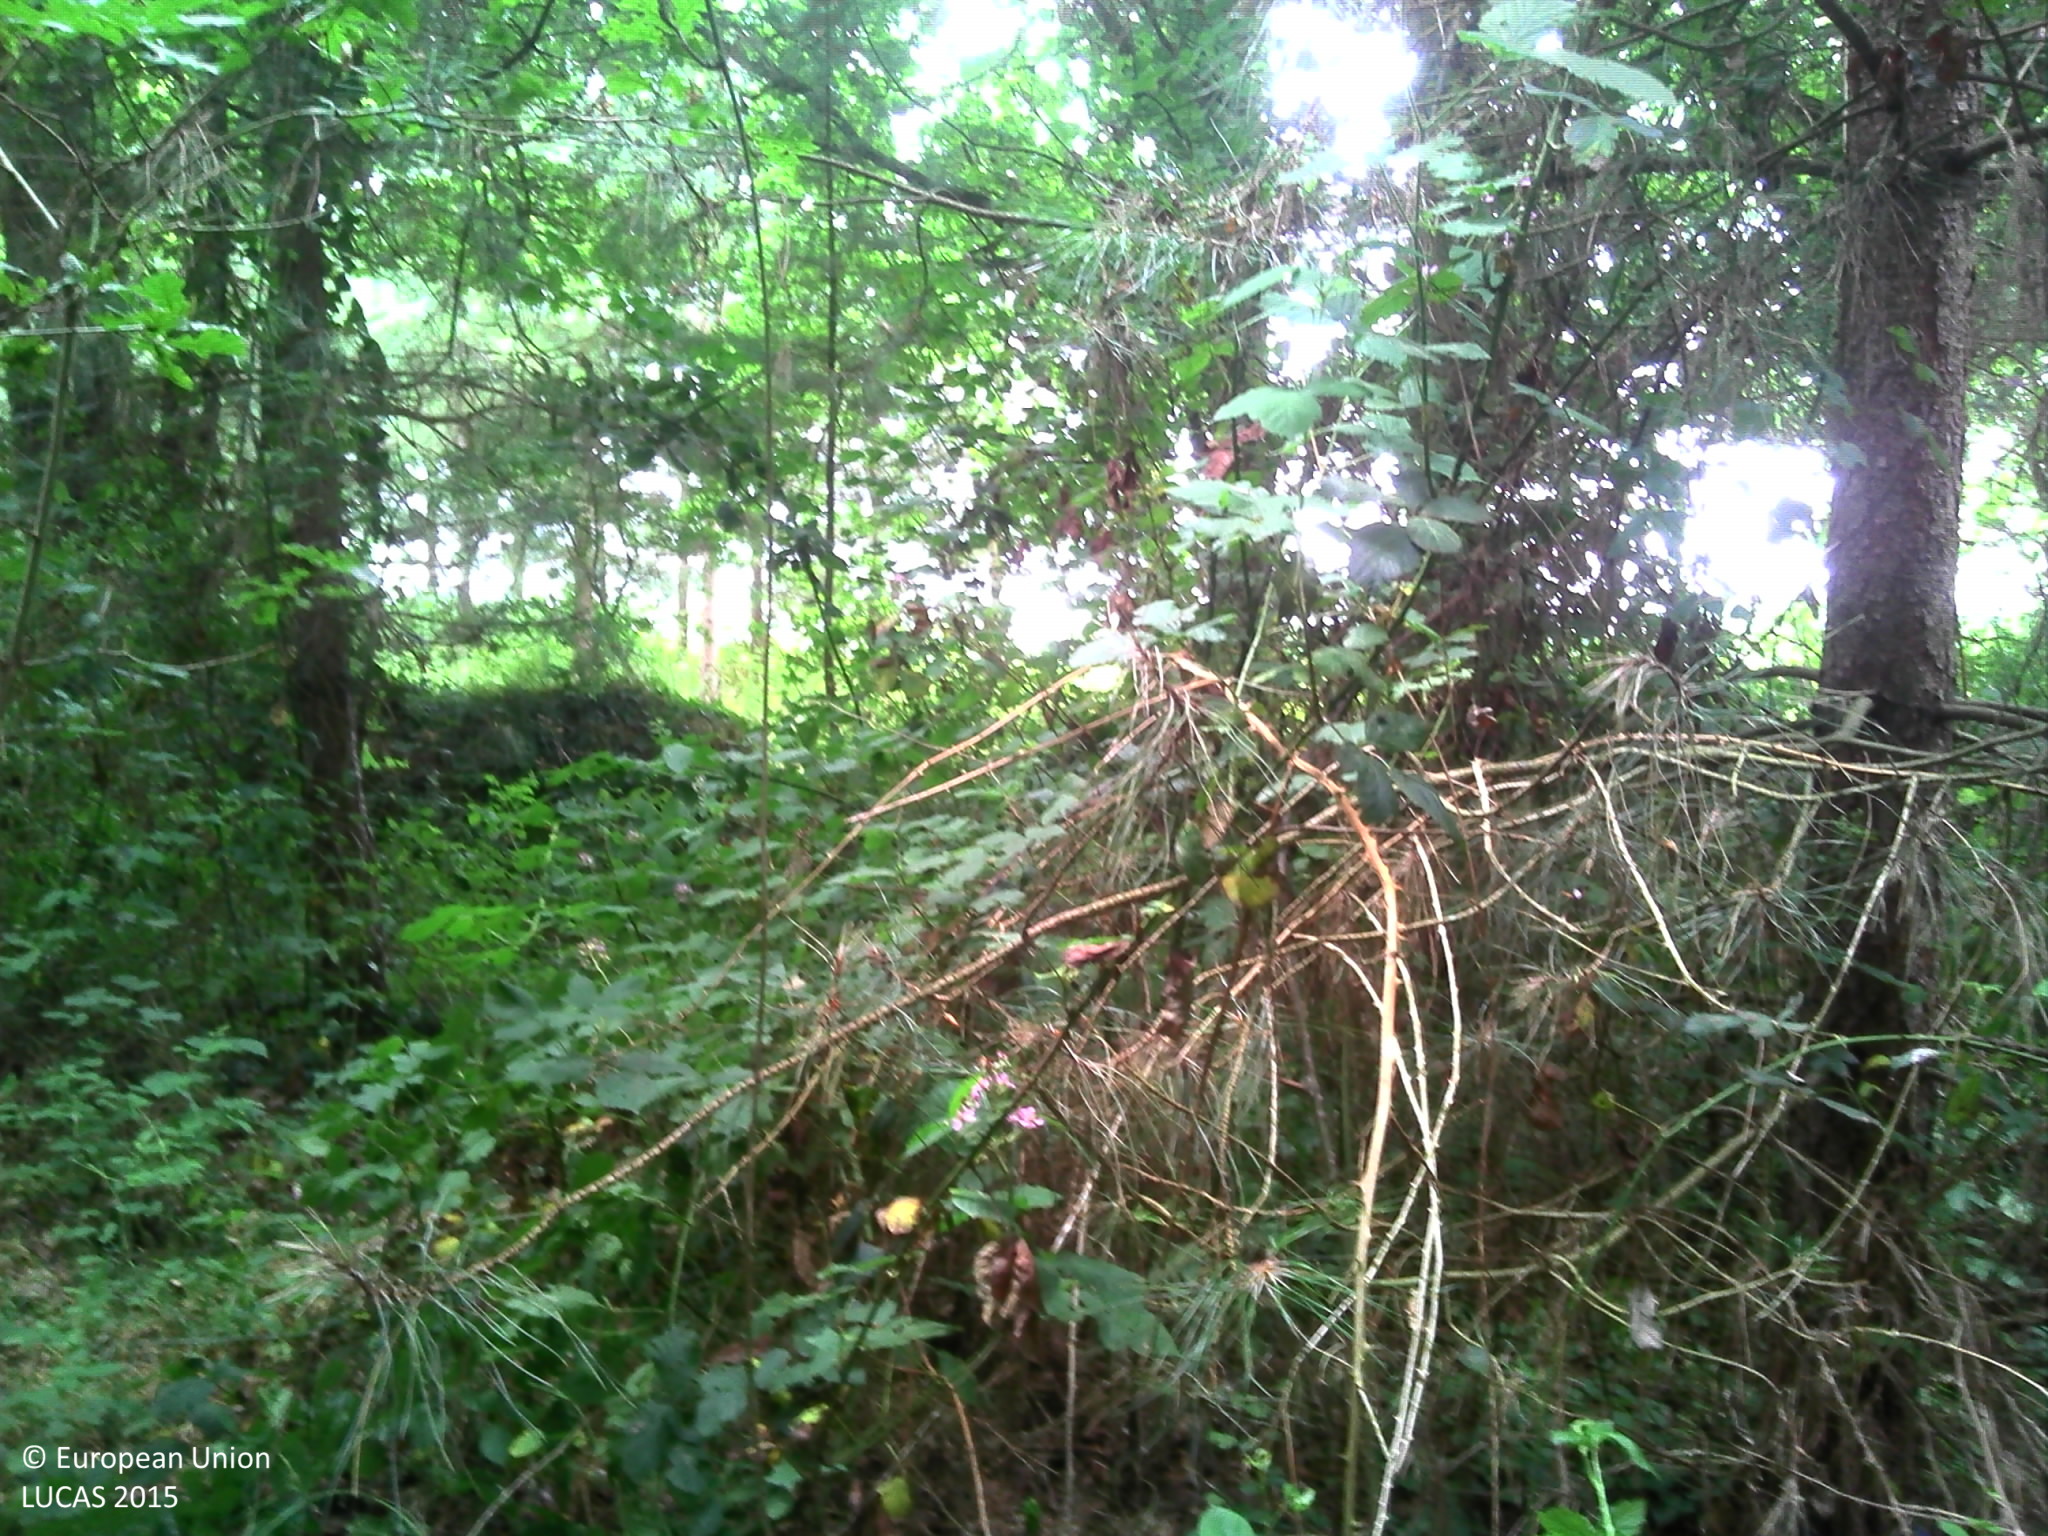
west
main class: Woodland
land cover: Pine dominated mixed woodland
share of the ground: > 75 %
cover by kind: coniferous forest trees 75 %, broadleaved forest trees 25 %
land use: Forestry
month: July
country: FR
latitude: 46.6934
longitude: -1.8251
